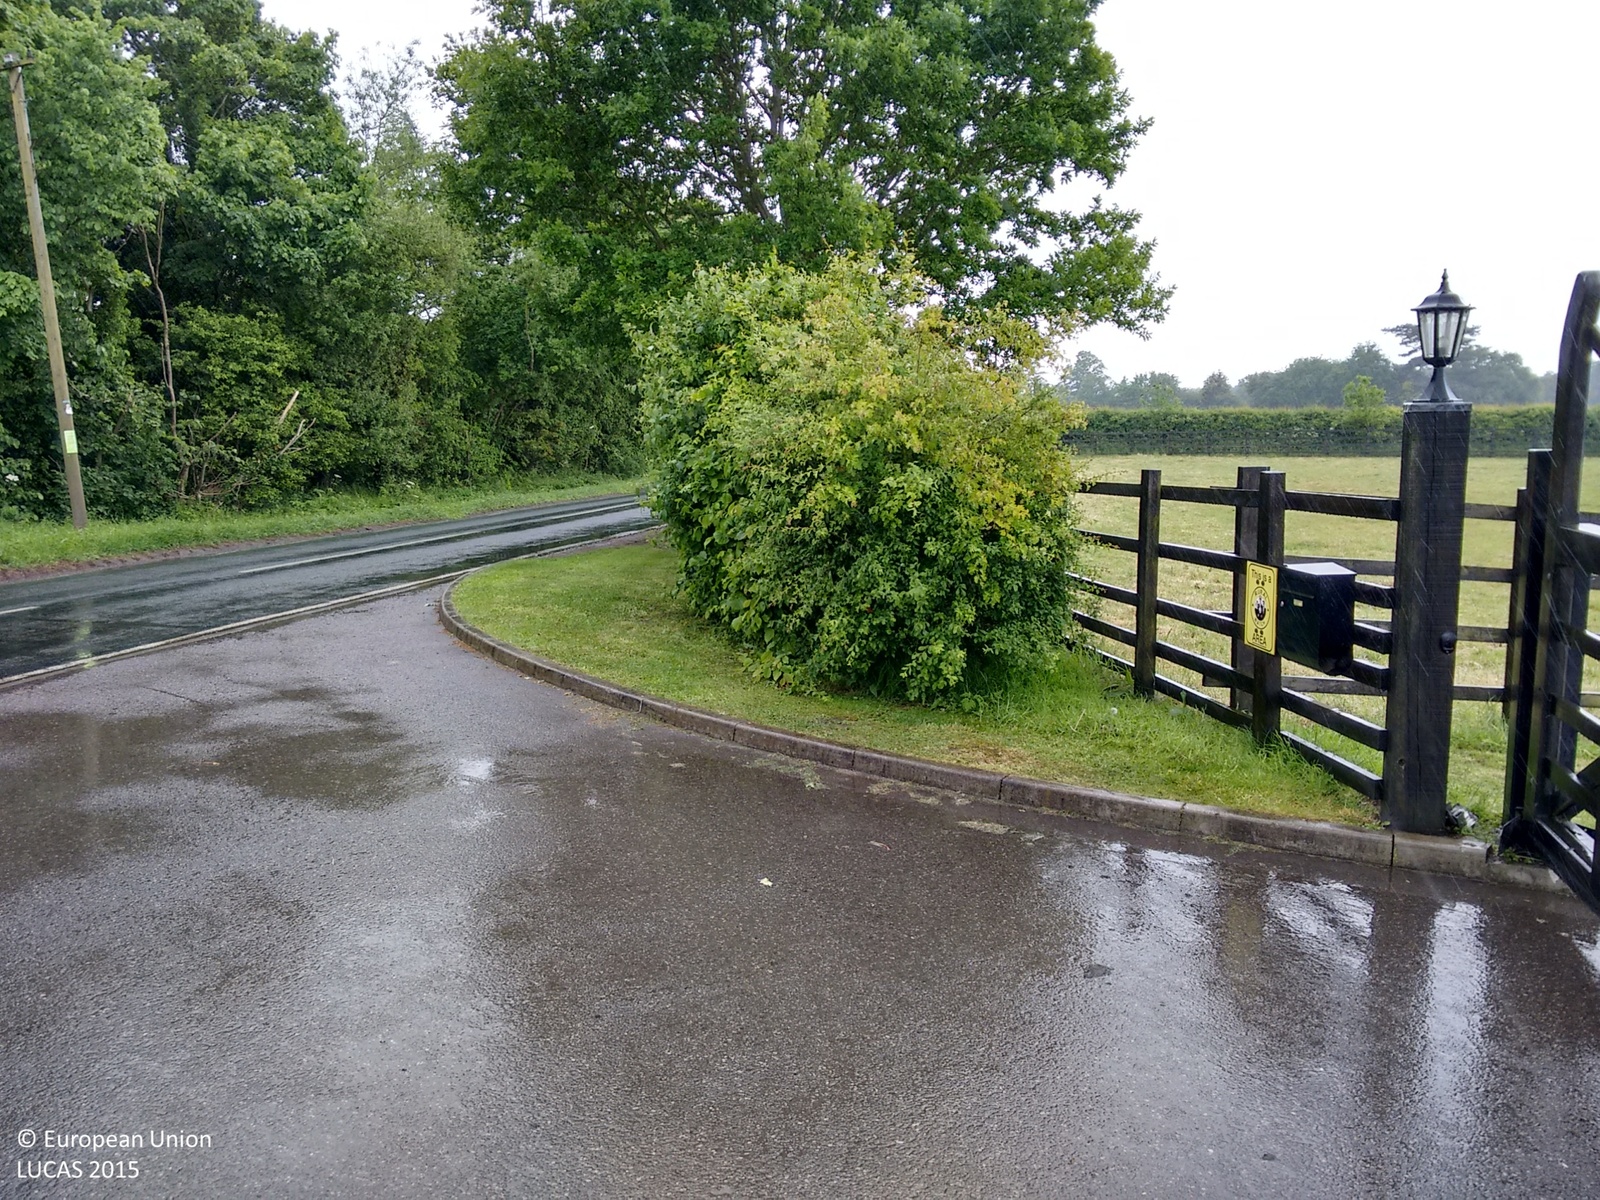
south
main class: Woodland
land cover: Broadleaved woodland
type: mesophytic deciduous forest
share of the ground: > 75 %
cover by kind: broadleaved forest trees 80 %, coniferous forest trees 20 %
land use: Semi-natural and natural areas not in use
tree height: > 5 m
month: June
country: GB
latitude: 53.8702
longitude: -1.1006
